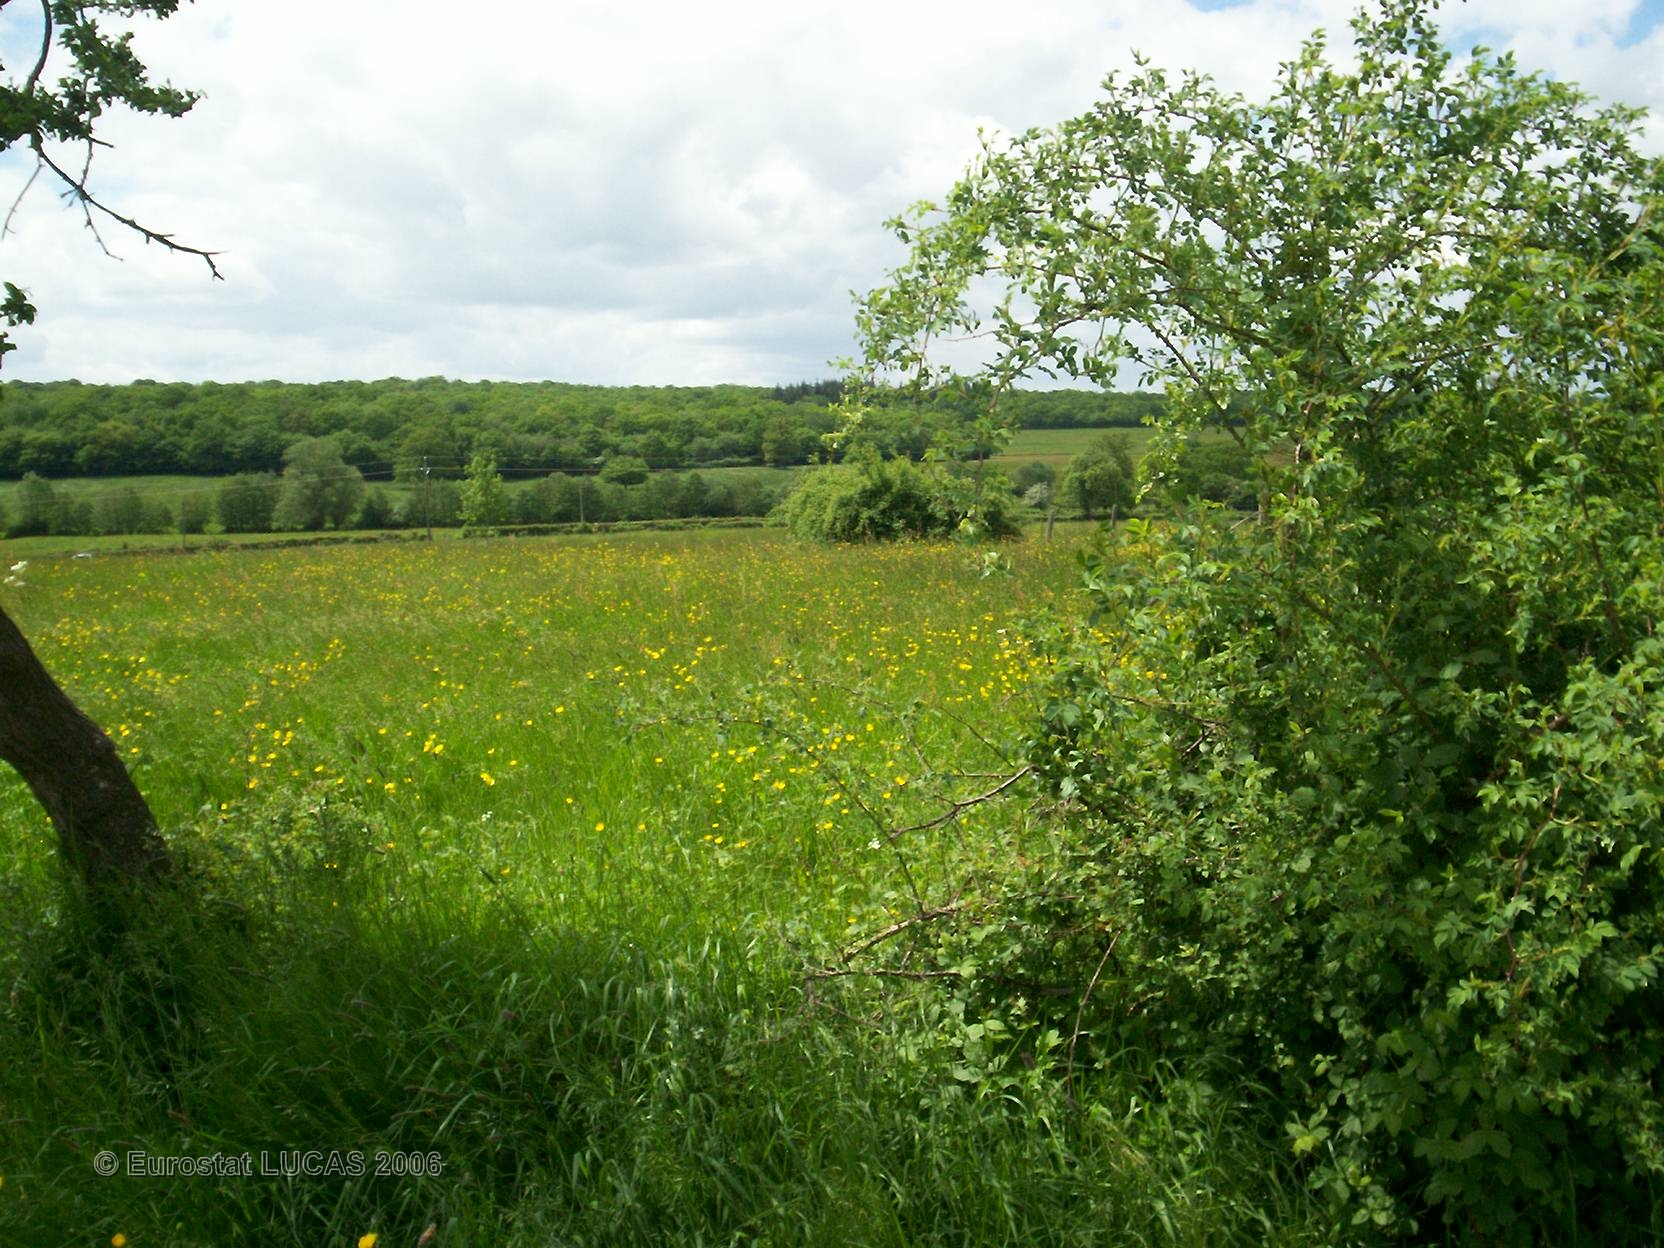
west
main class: Grassland
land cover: Grassland without tree/shrub cover
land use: Agriculture (excluding fallow land and kitchen gardens)
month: May
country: FR
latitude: 47.0638
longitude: 4.6150
